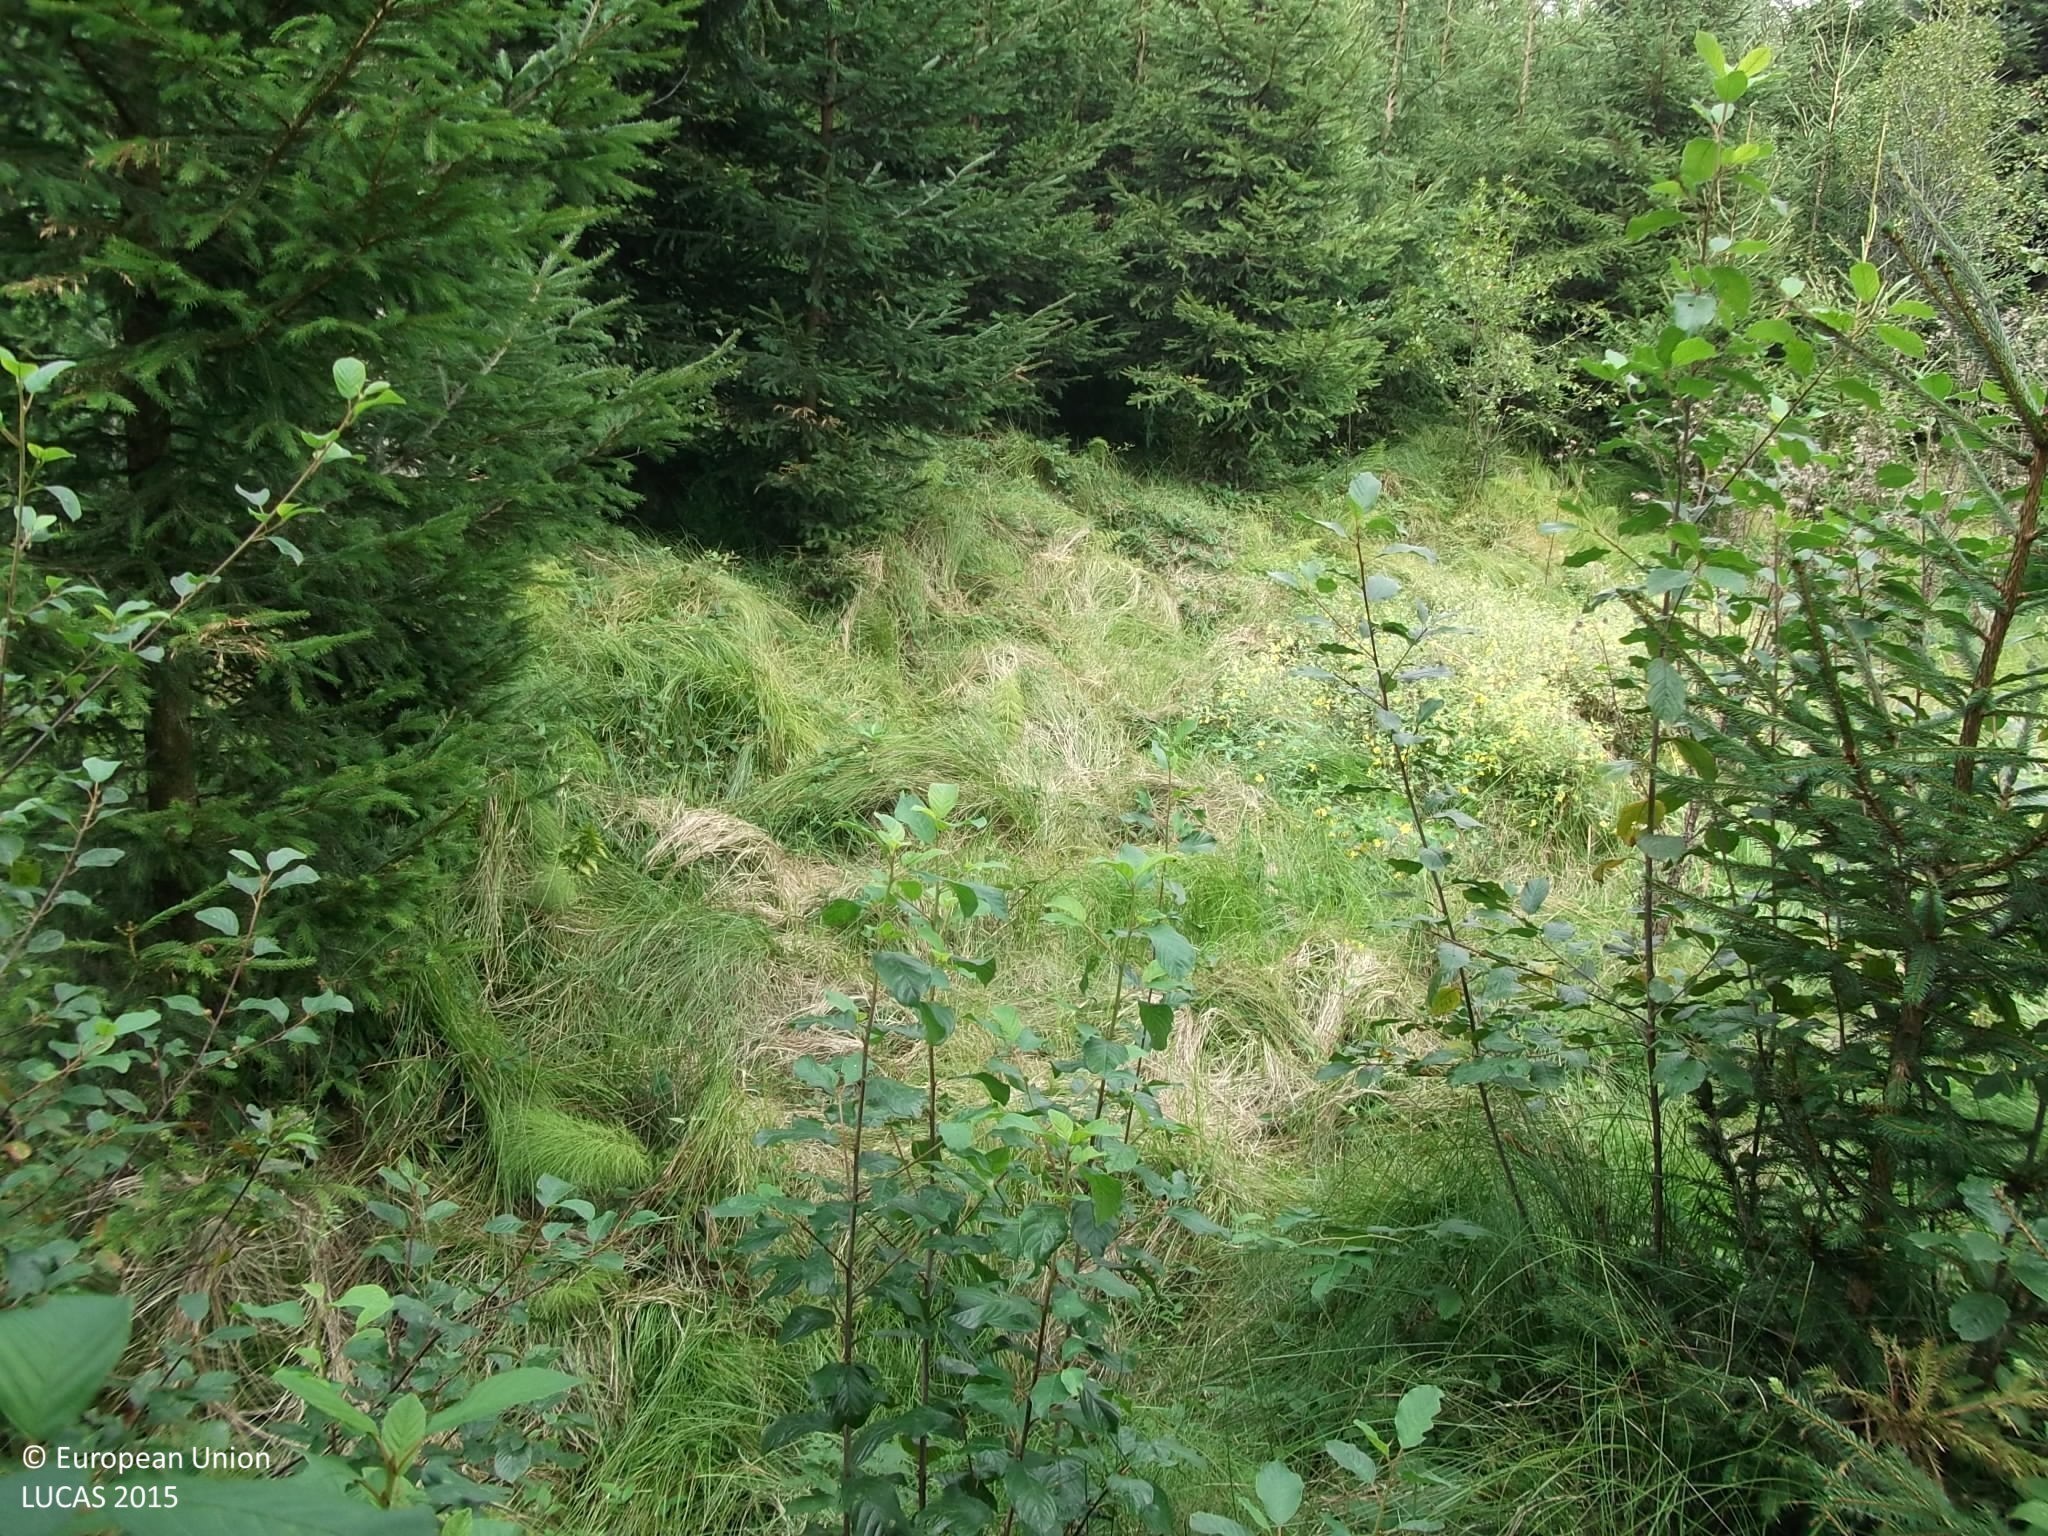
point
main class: Grassland
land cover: Grassland with sparse tree/shrub cover
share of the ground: > 75 %
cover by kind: herbaceous plants 90 %, coniferous forest trees 5 %, shrubs 5 %
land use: Forestry
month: August
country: AT
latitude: 47.9742
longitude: 13.3613
